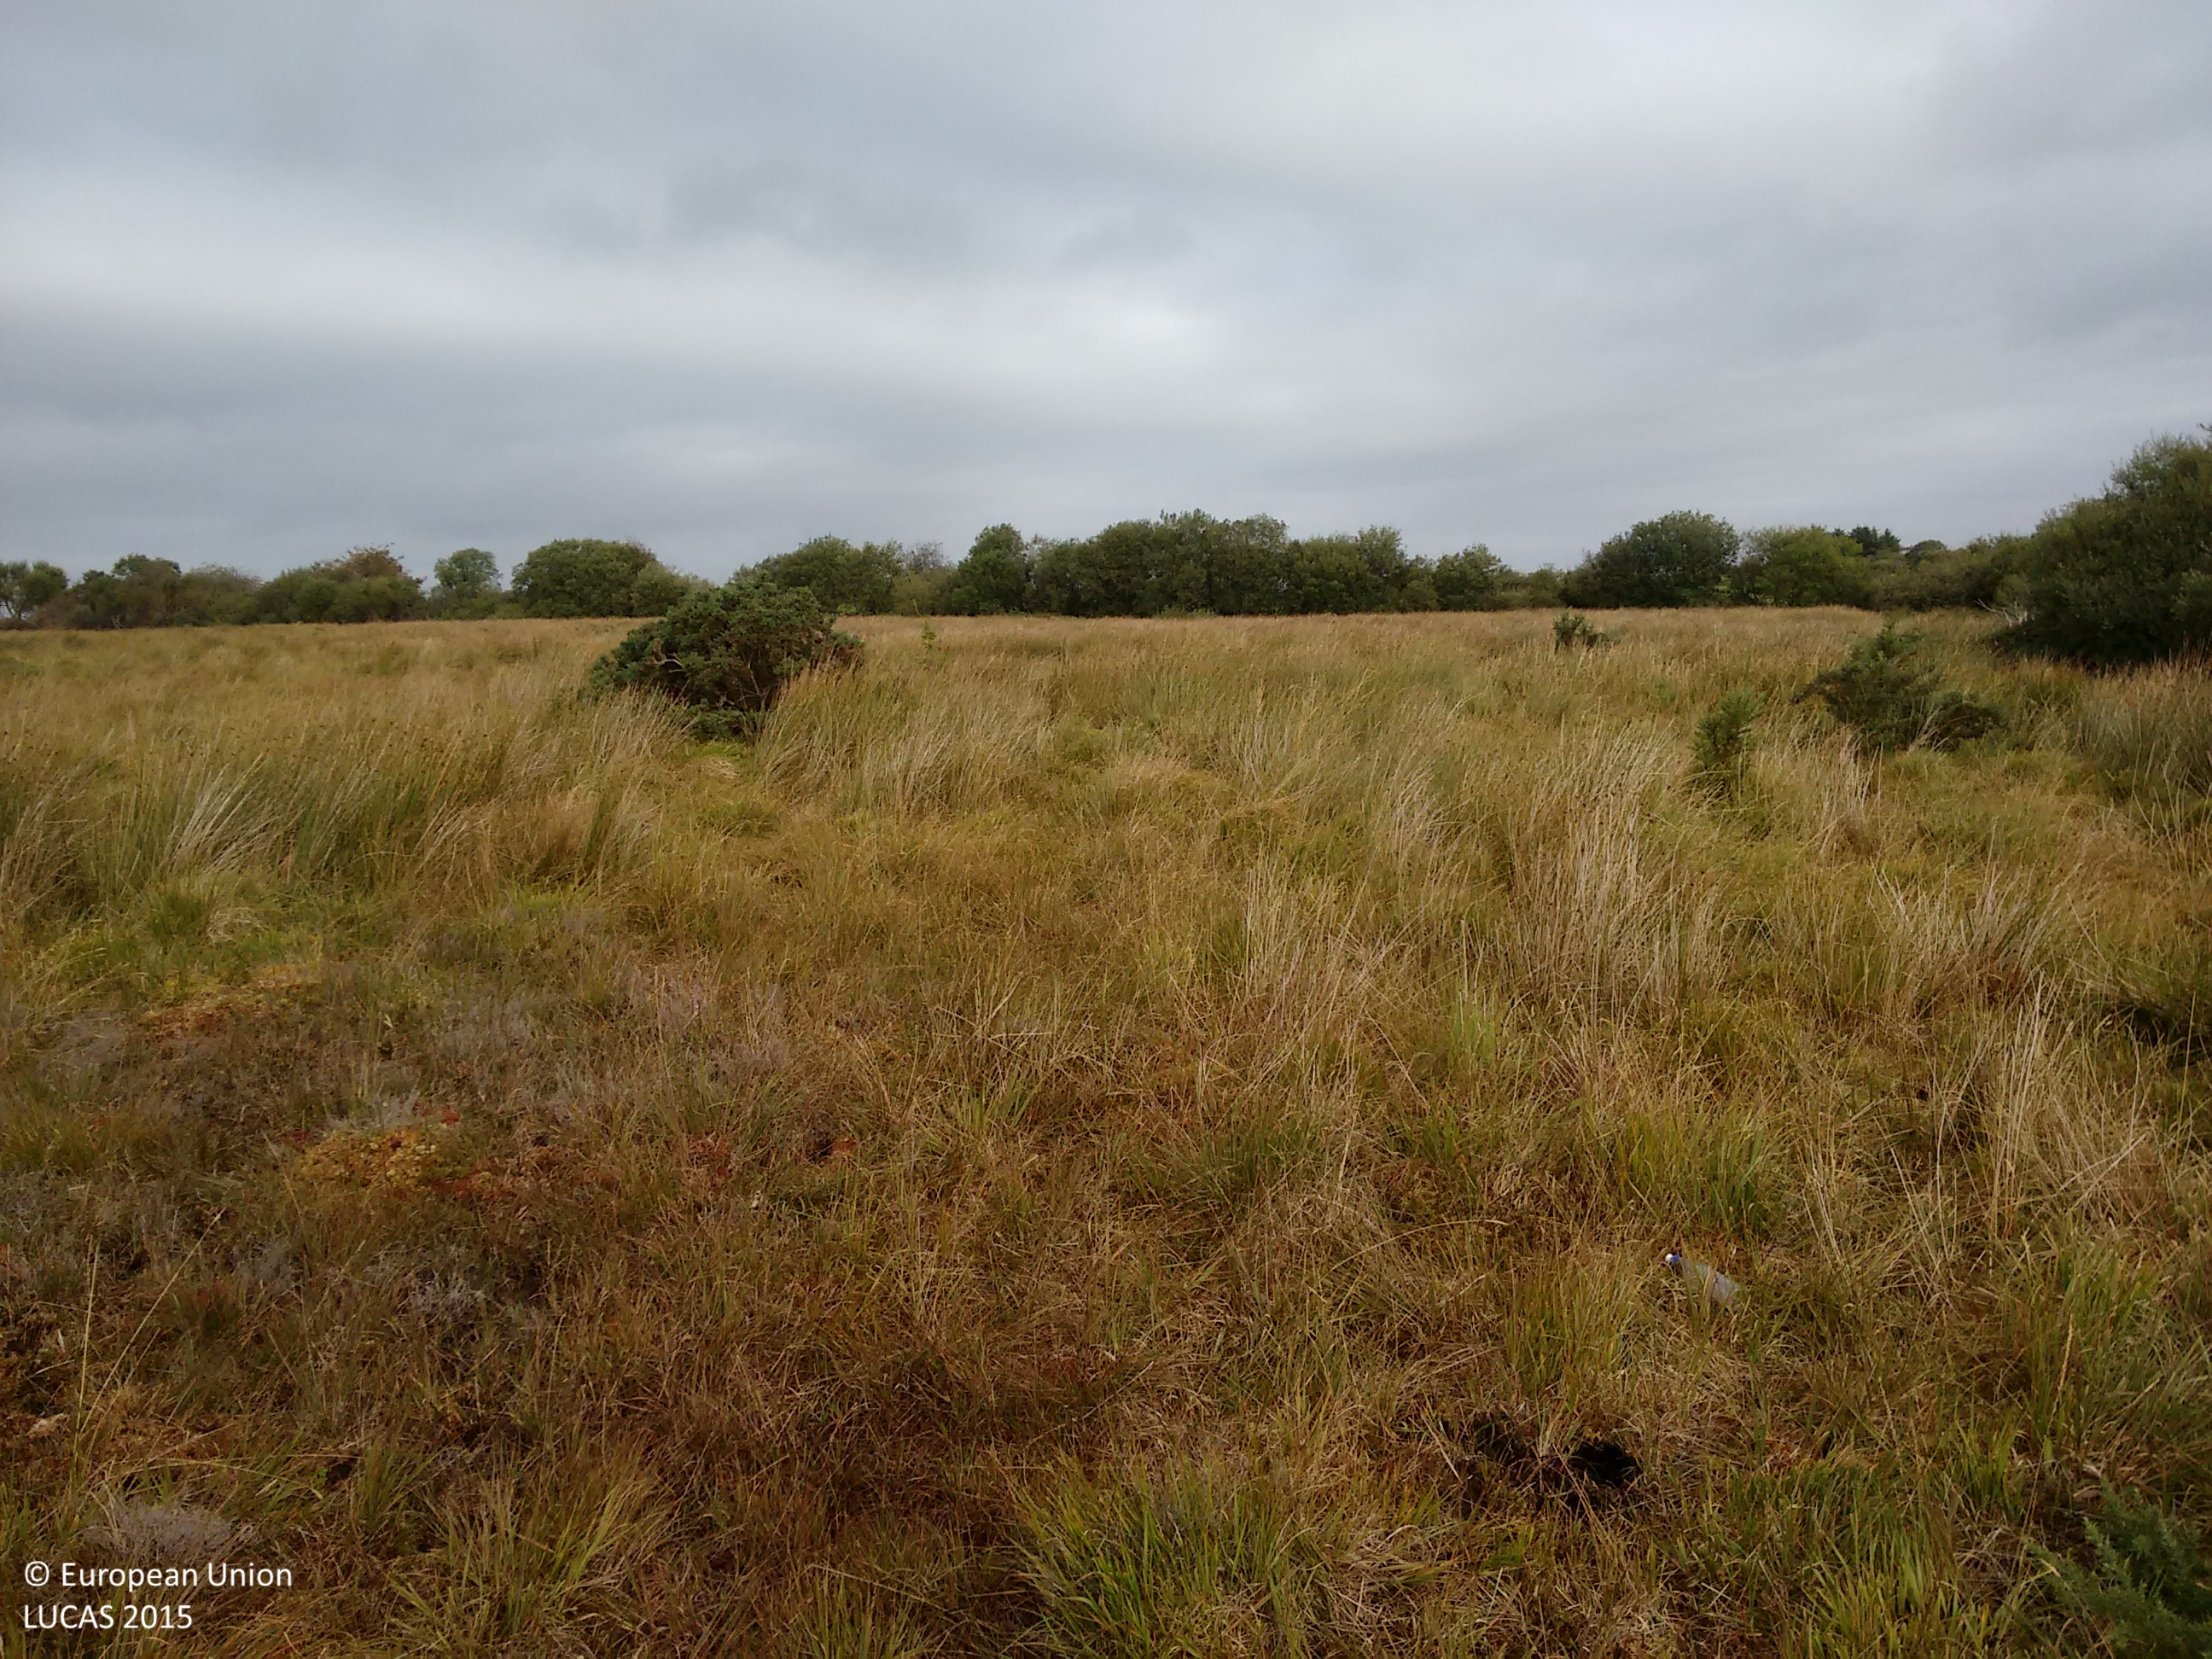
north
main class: Grassland
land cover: Grassland with sparse tree/shrub cover
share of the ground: > 75 %
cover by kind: herbaceous plants 85 %, shrubs 10 %, broadleaved forest trees 5 %
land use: Agriculture (excluding fallow land and kitchen gardens)
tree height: < 5 m
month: September
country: IE
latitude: 53.7603
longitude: -8.9114
